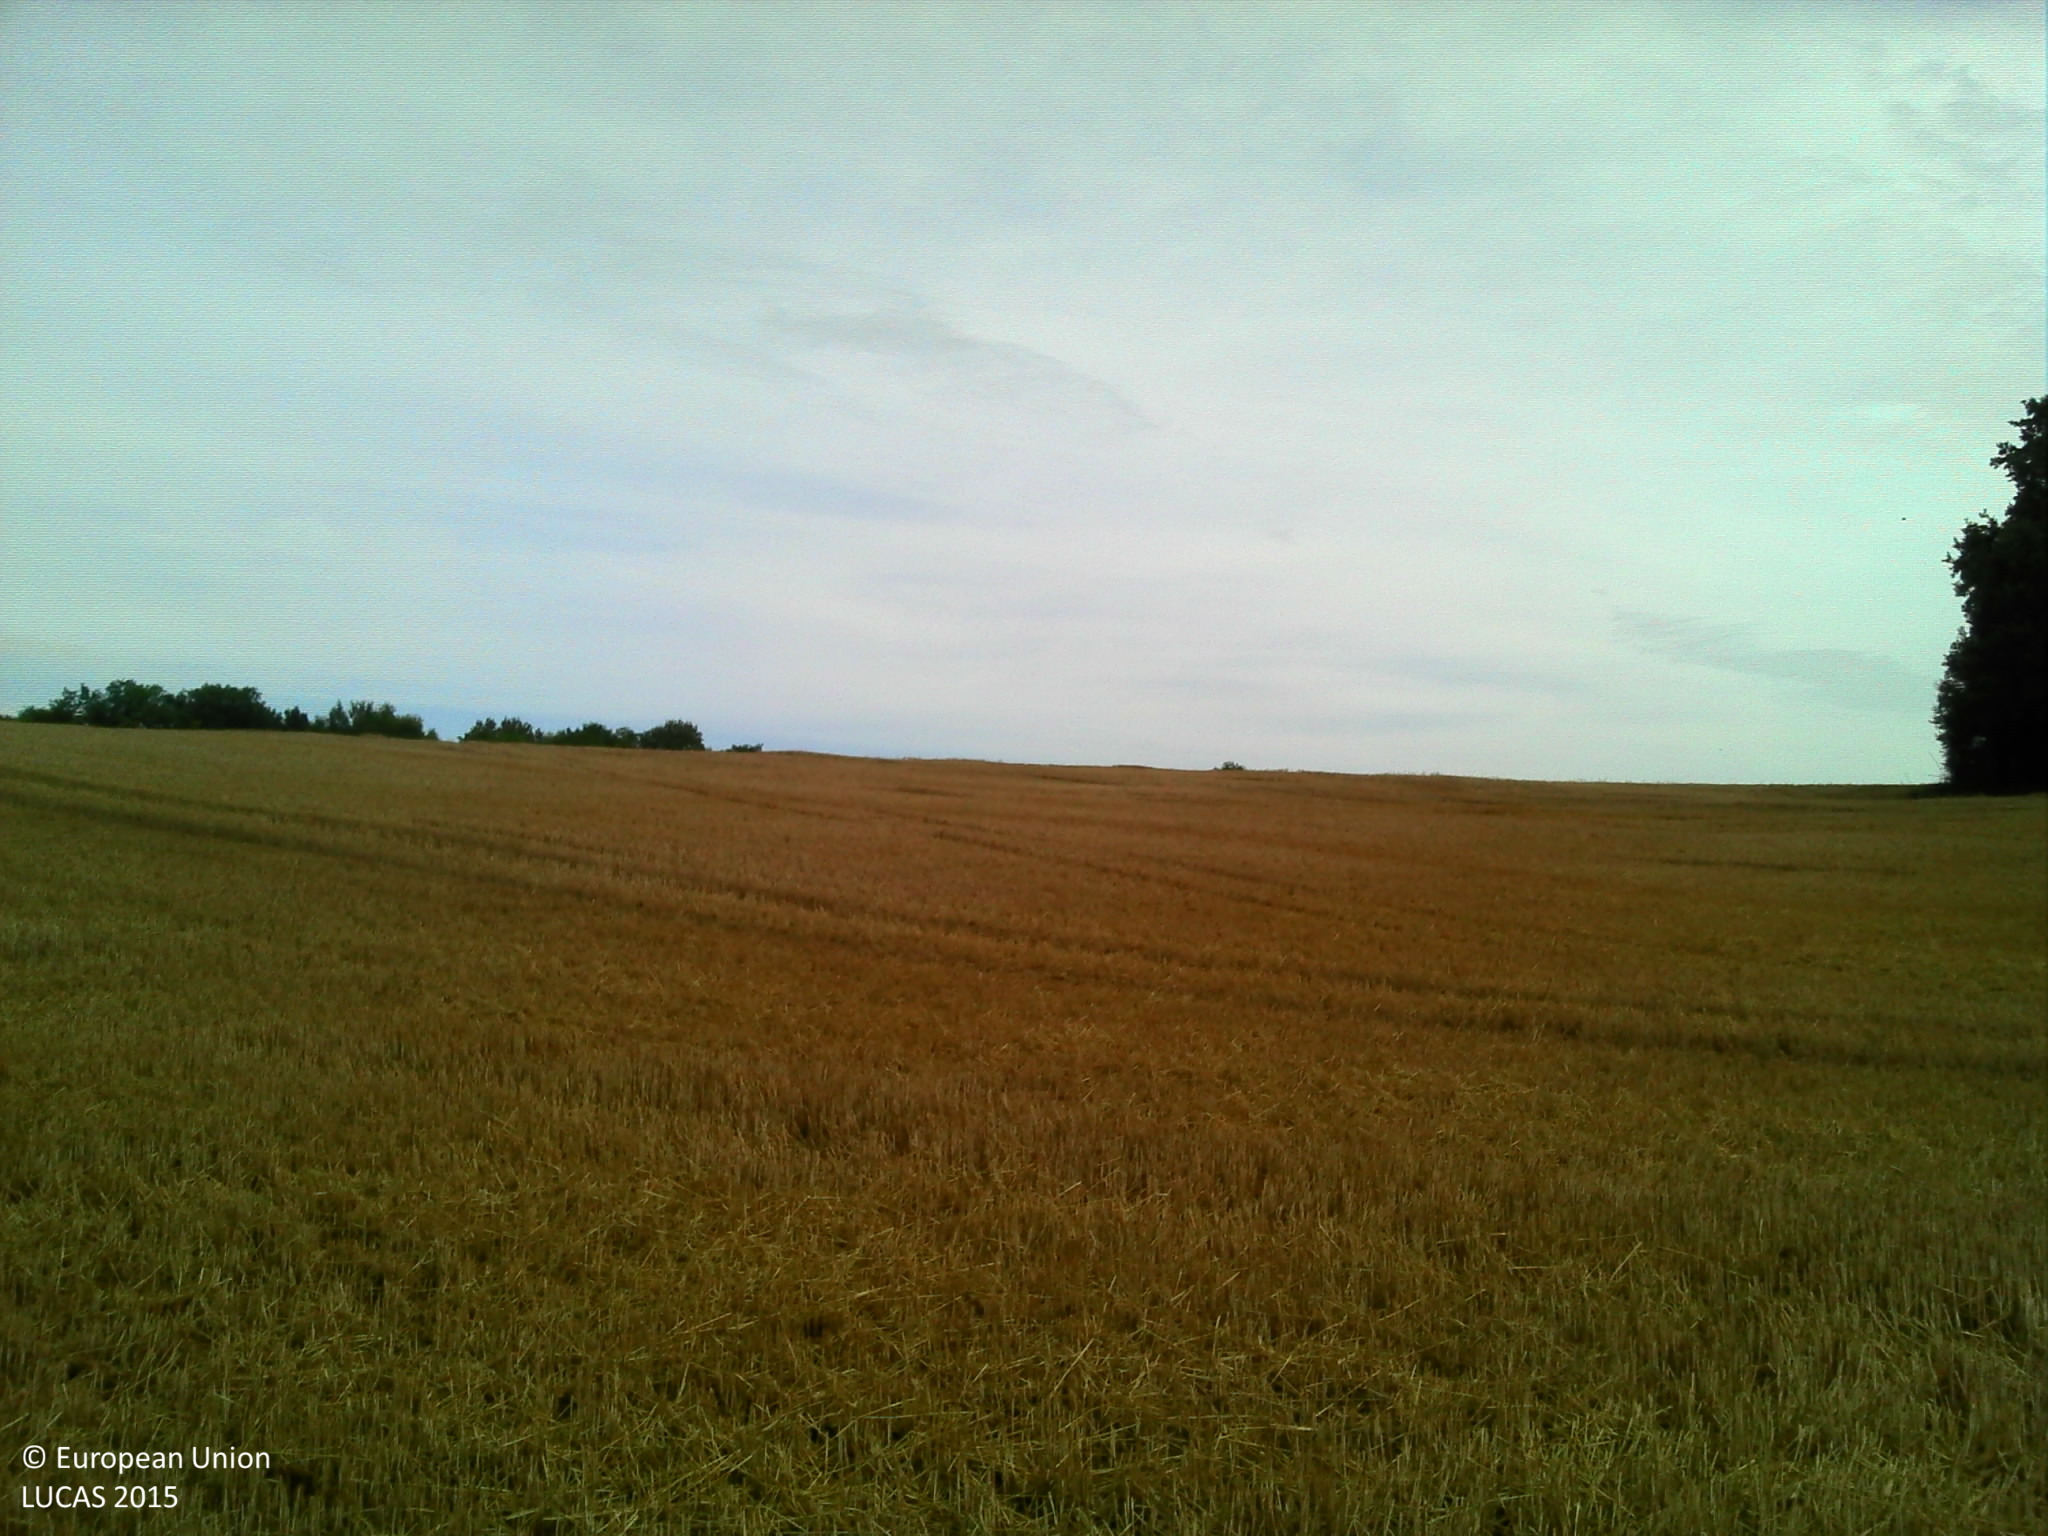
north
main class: Cropland
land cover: Common wheat
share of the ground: > 75 %
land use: Agriculture (excluding fallow land and kitchen gardens)
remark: Harvested field
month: July
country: FR
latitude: 49.1701
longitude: 2.9270
